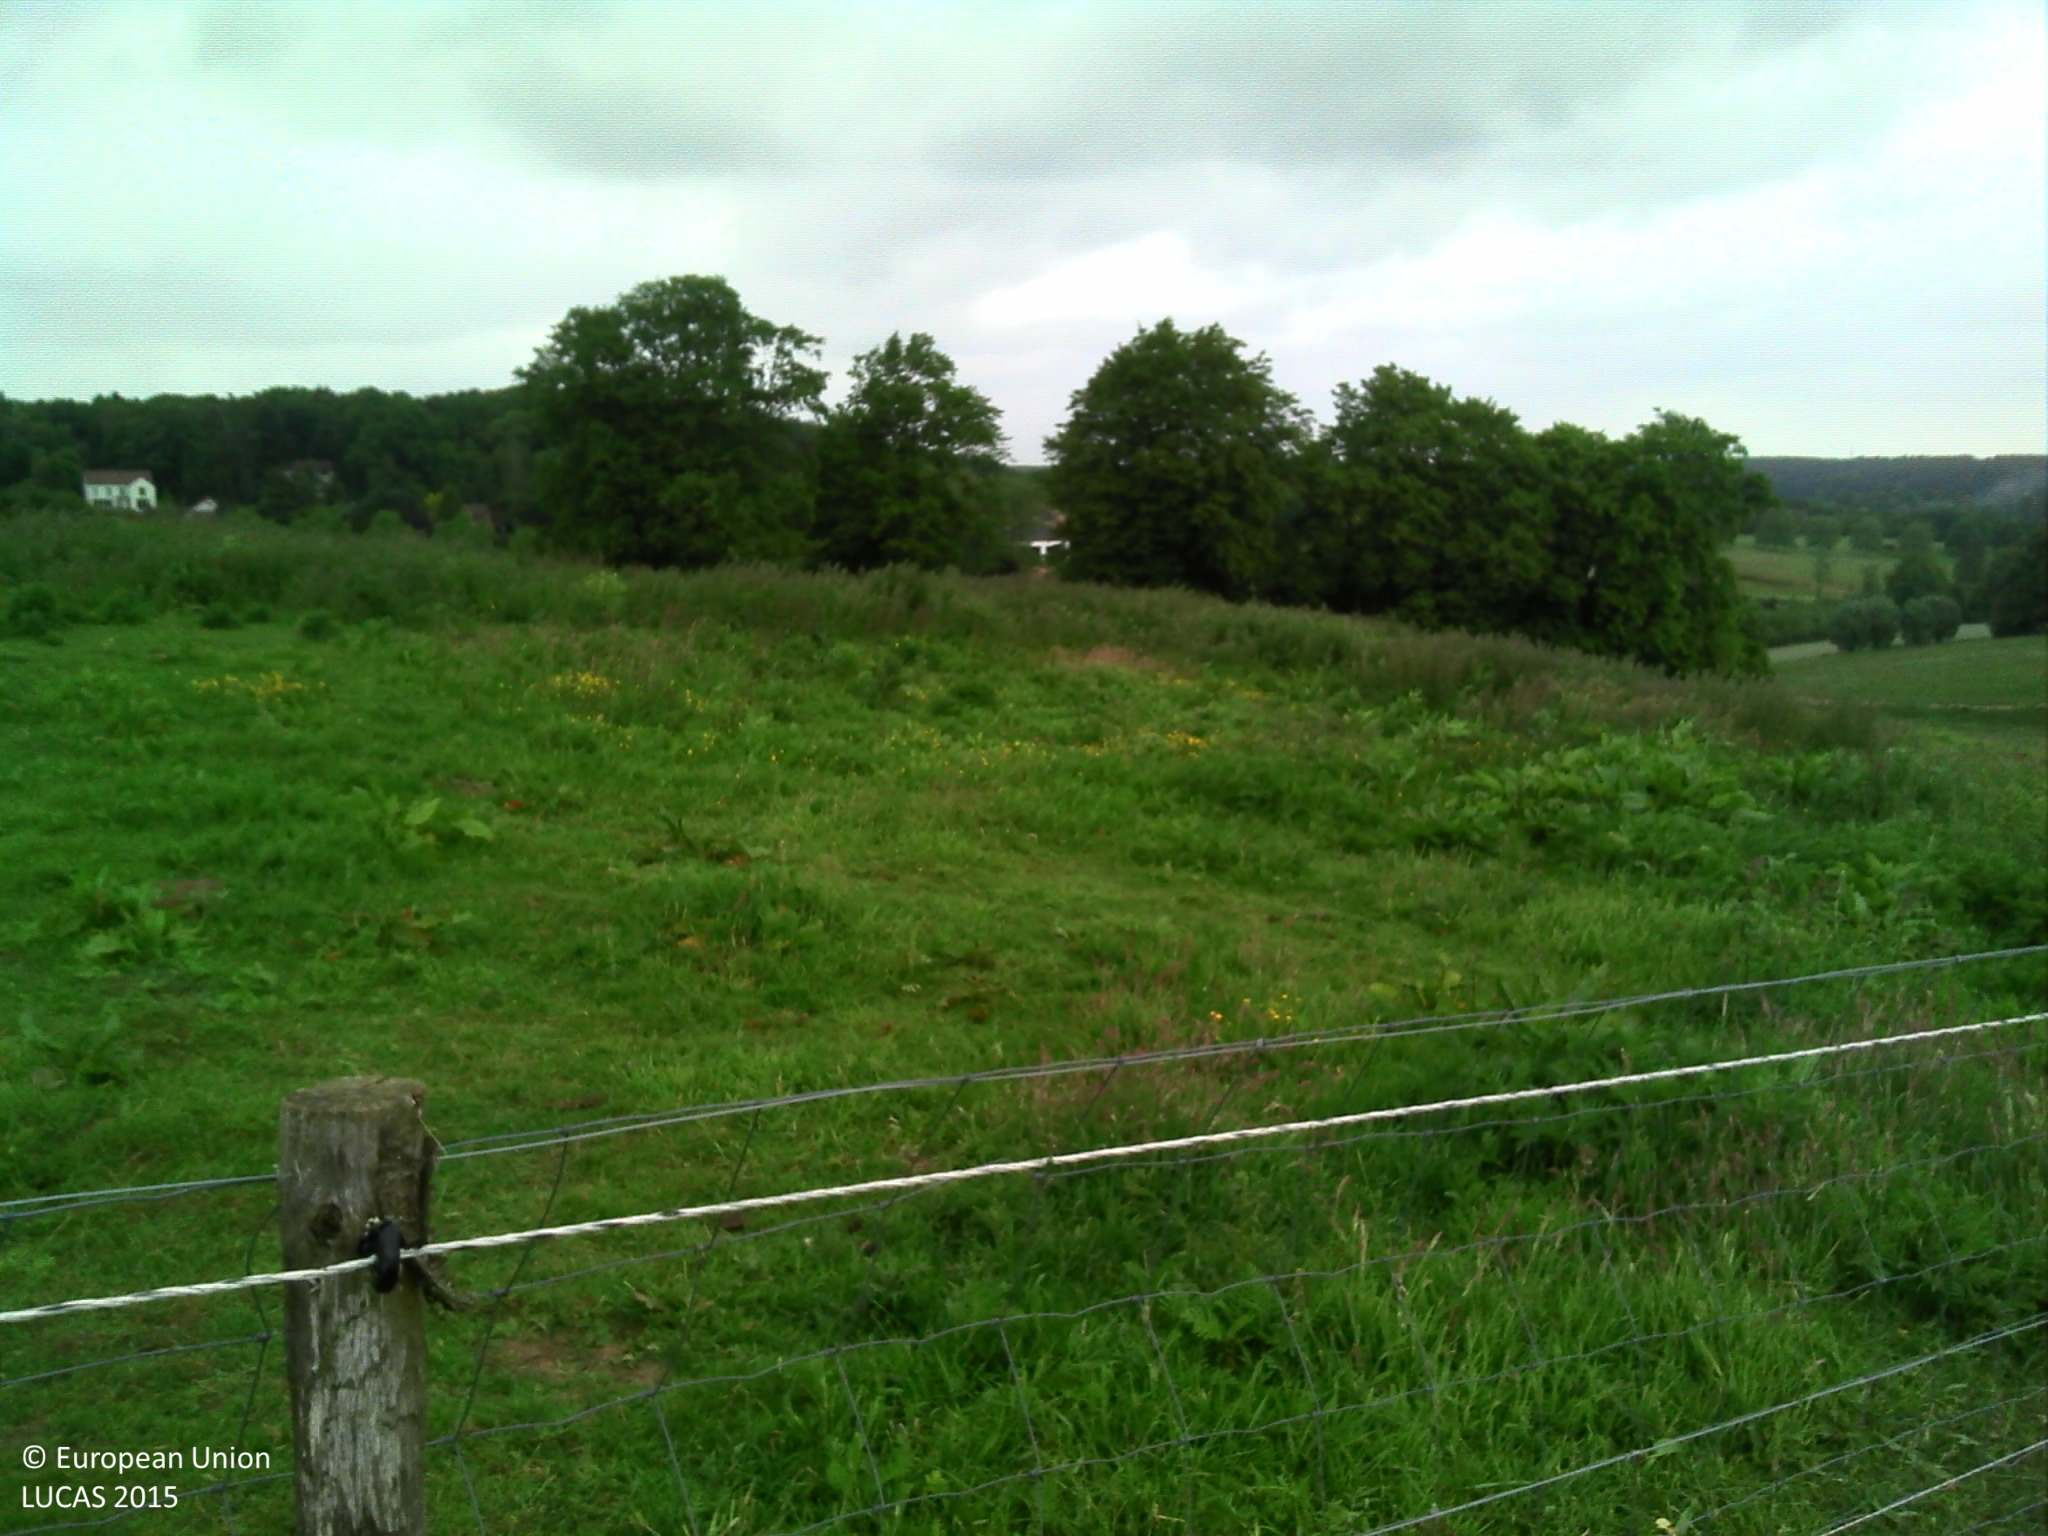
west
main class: Grassland
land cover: Grassland without tree/shrub cover
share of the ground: > 75 %
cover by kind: herbaceous plants 100 %
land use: Agriculture (excluding fallow land and kitchen gardens)
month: May
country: BE
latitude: 50.6268
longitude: 4.4684
